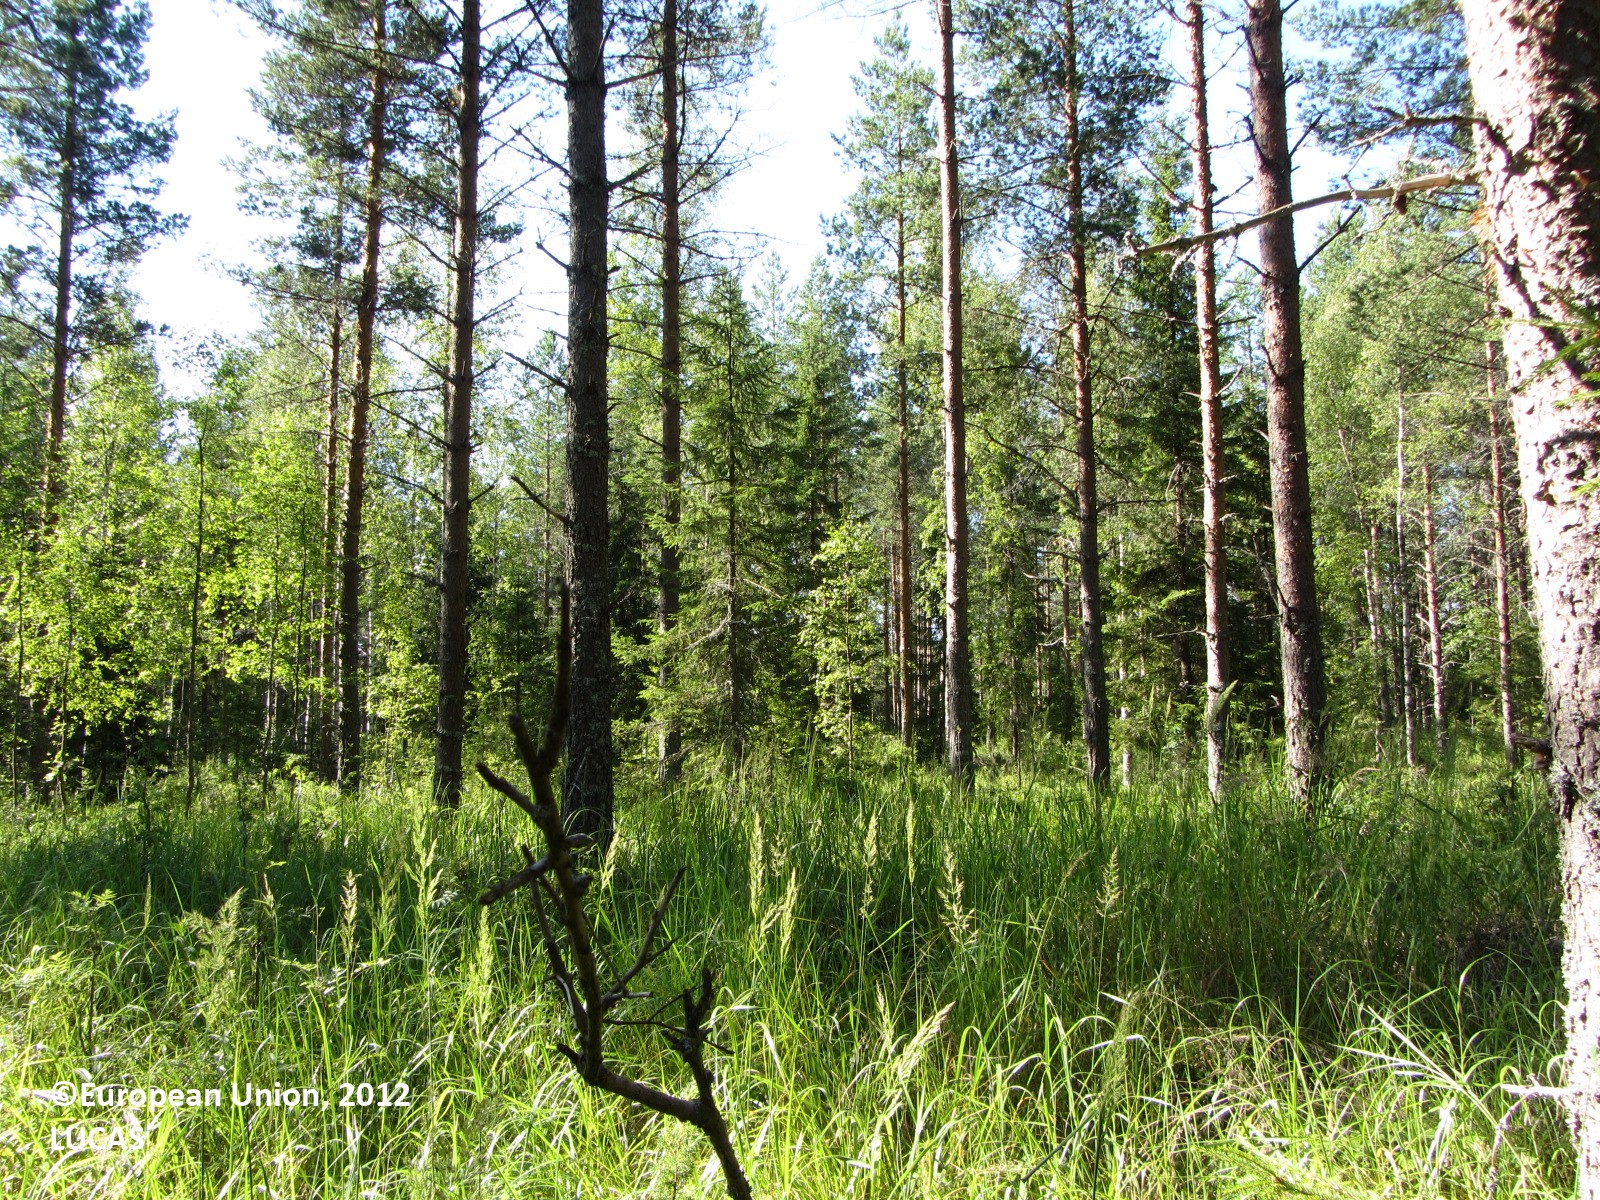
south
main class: Woodland
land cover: Pine dominated coniferous woodland
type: boreal forest
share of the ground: 50 - 75 %
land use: Forestry
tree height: > 5 m
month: July
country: FI
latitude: 63.6370
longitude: 24.6754
